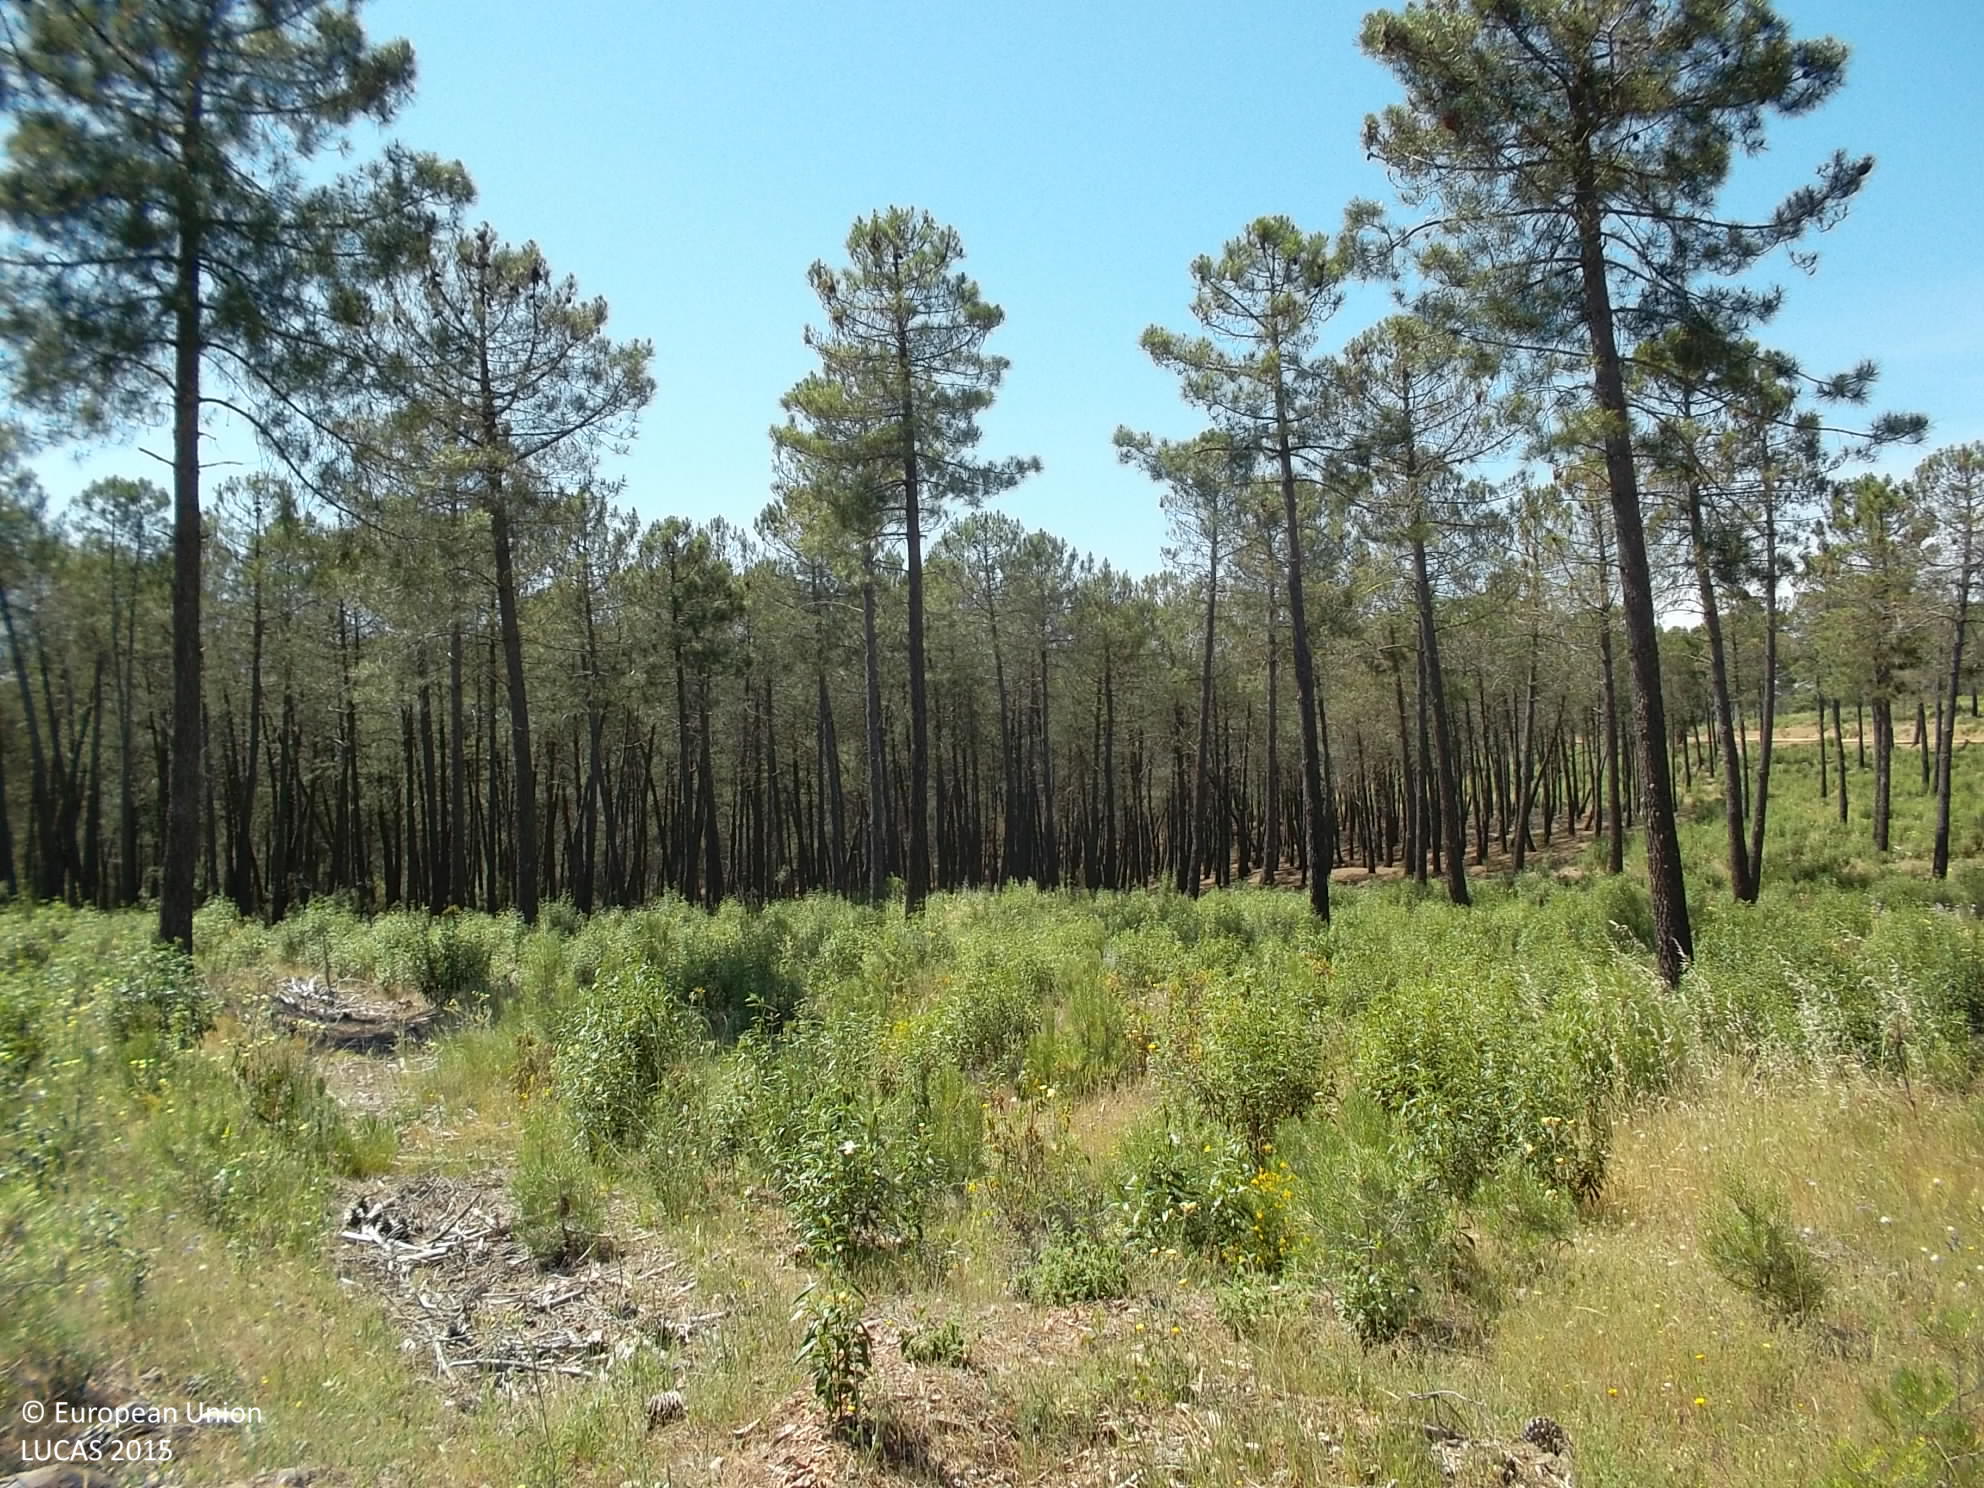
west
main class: Woodland
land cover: Pine dominated coniferous woodland
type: broadleaved evergreen forest
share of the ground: 25 - 50 %
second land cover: Spontaneously vegetated surfaces
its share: > 75 %
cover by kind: coniferous forest trees 40 %, herbaceous plants 30 %, consolidated bare surface 20 %, shrubs 10 %
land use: Forestry
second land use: Agriculture (excluding fallow land and kitchen gardens)
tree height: > 5 m
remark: Clear cut
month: May
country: ES
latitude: 38.8197
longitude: -4.4797
